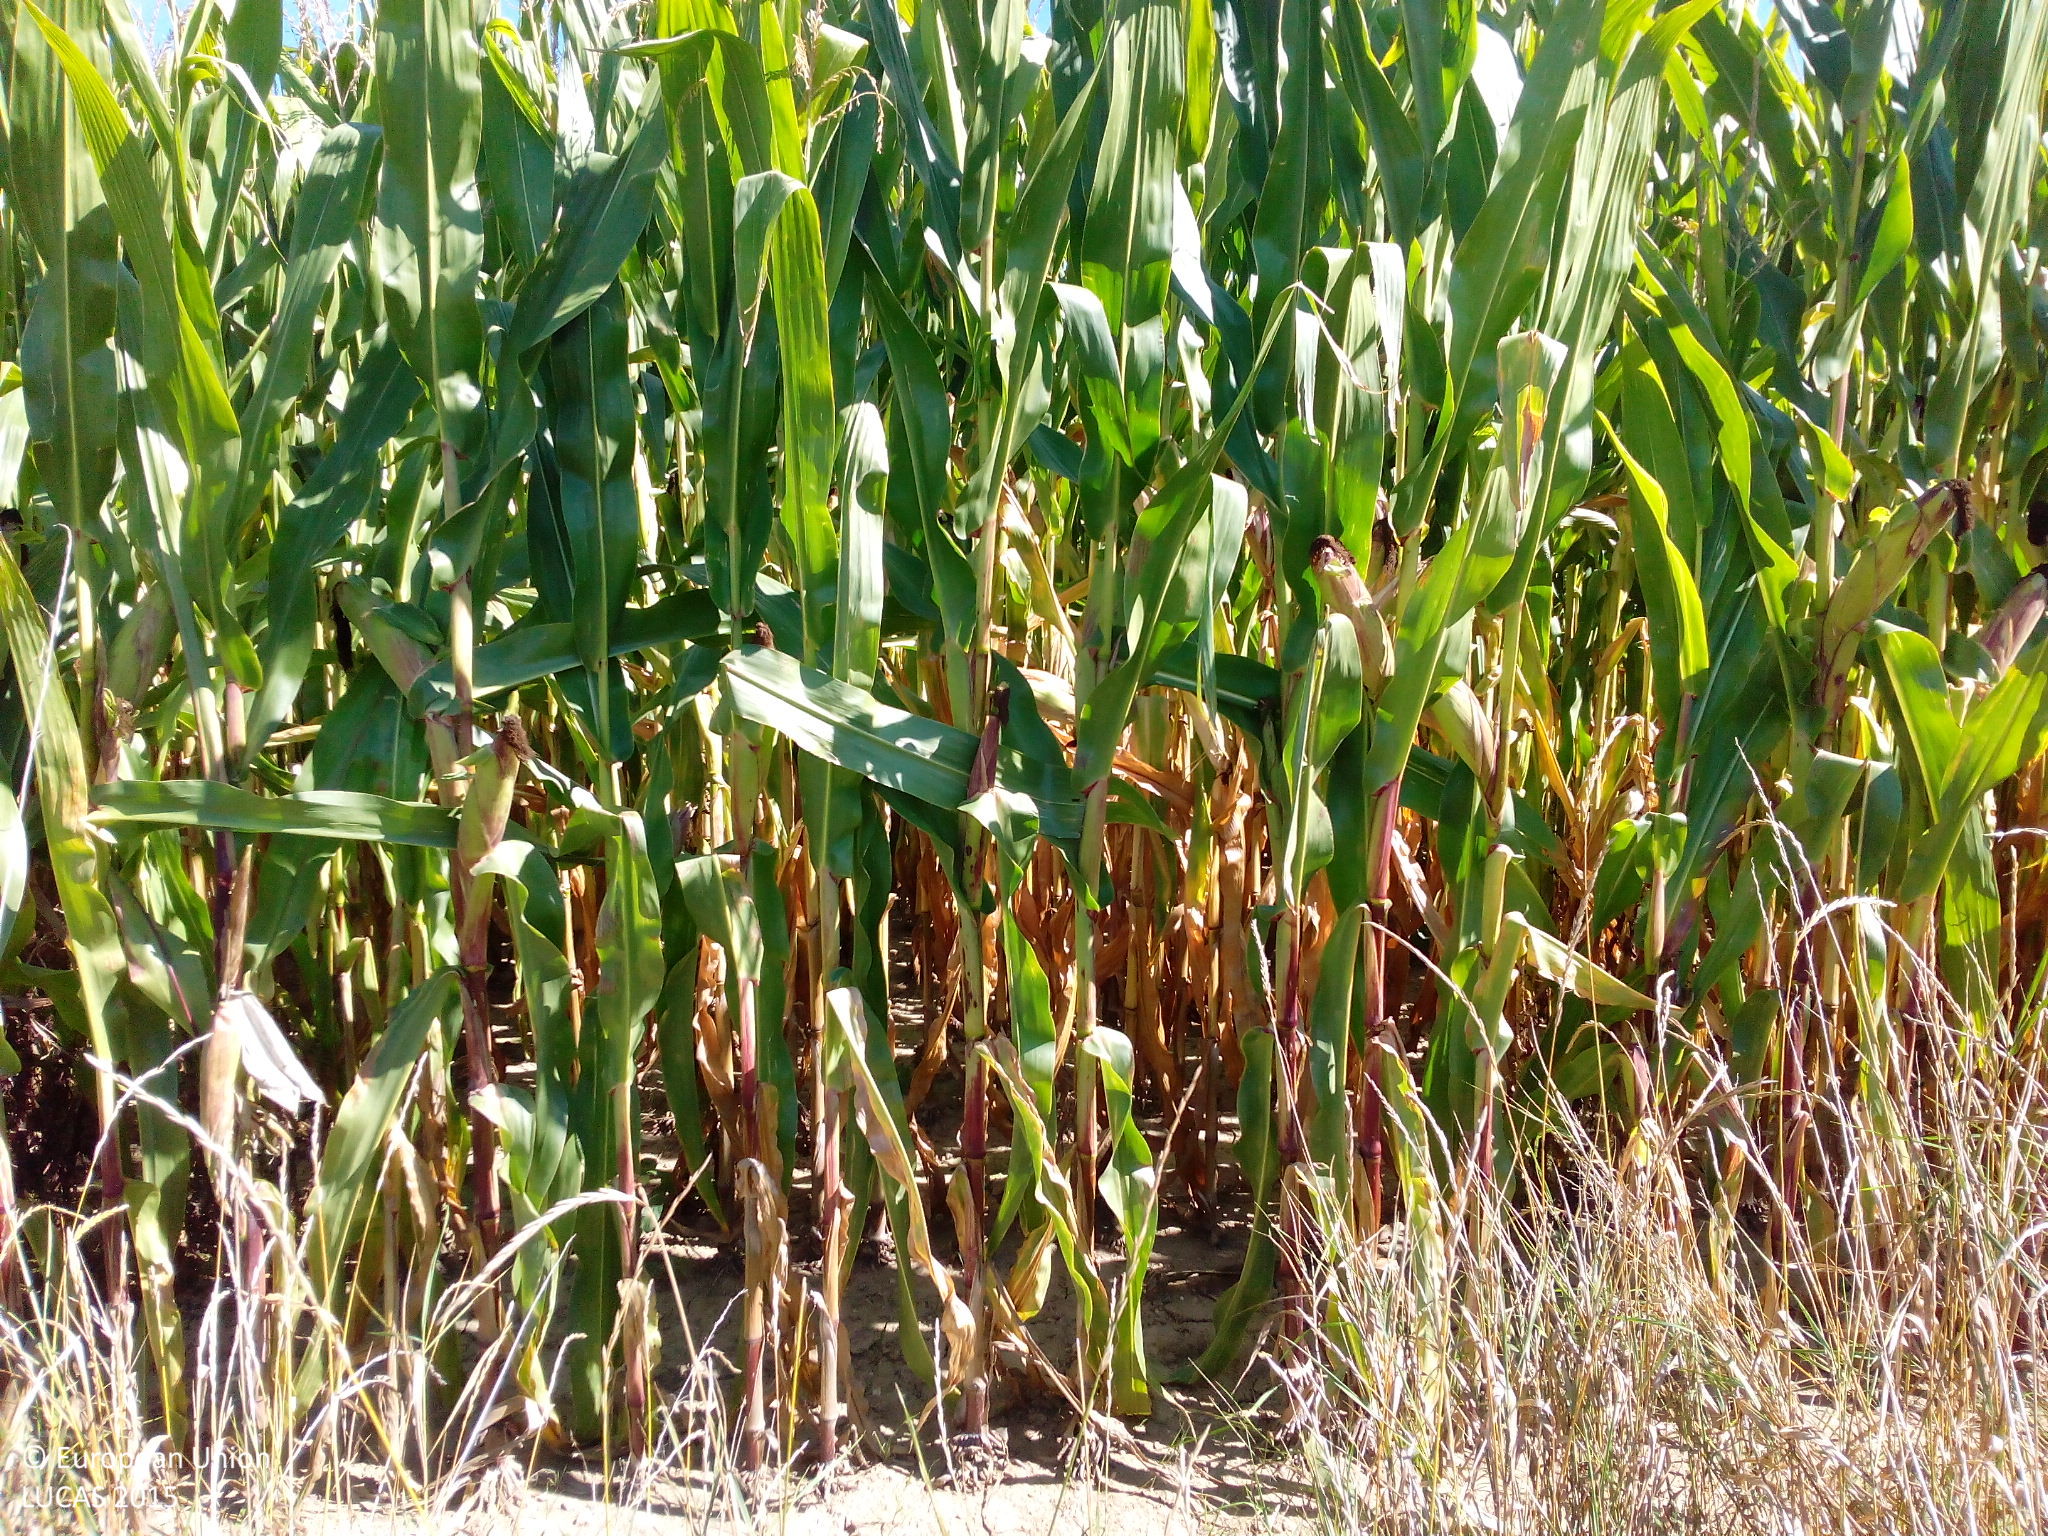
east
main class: Cropland
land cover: Maize
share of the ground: > 75 %
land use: Agriculture (excluding fallow land and kitchen gardens)
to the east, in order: Maize; Grassland without tree/shrub cover; Paved roads, cycling and walking lanes; Lines of trees; Maize
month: September
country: DE
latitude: 48.3842
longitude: 12.0650
